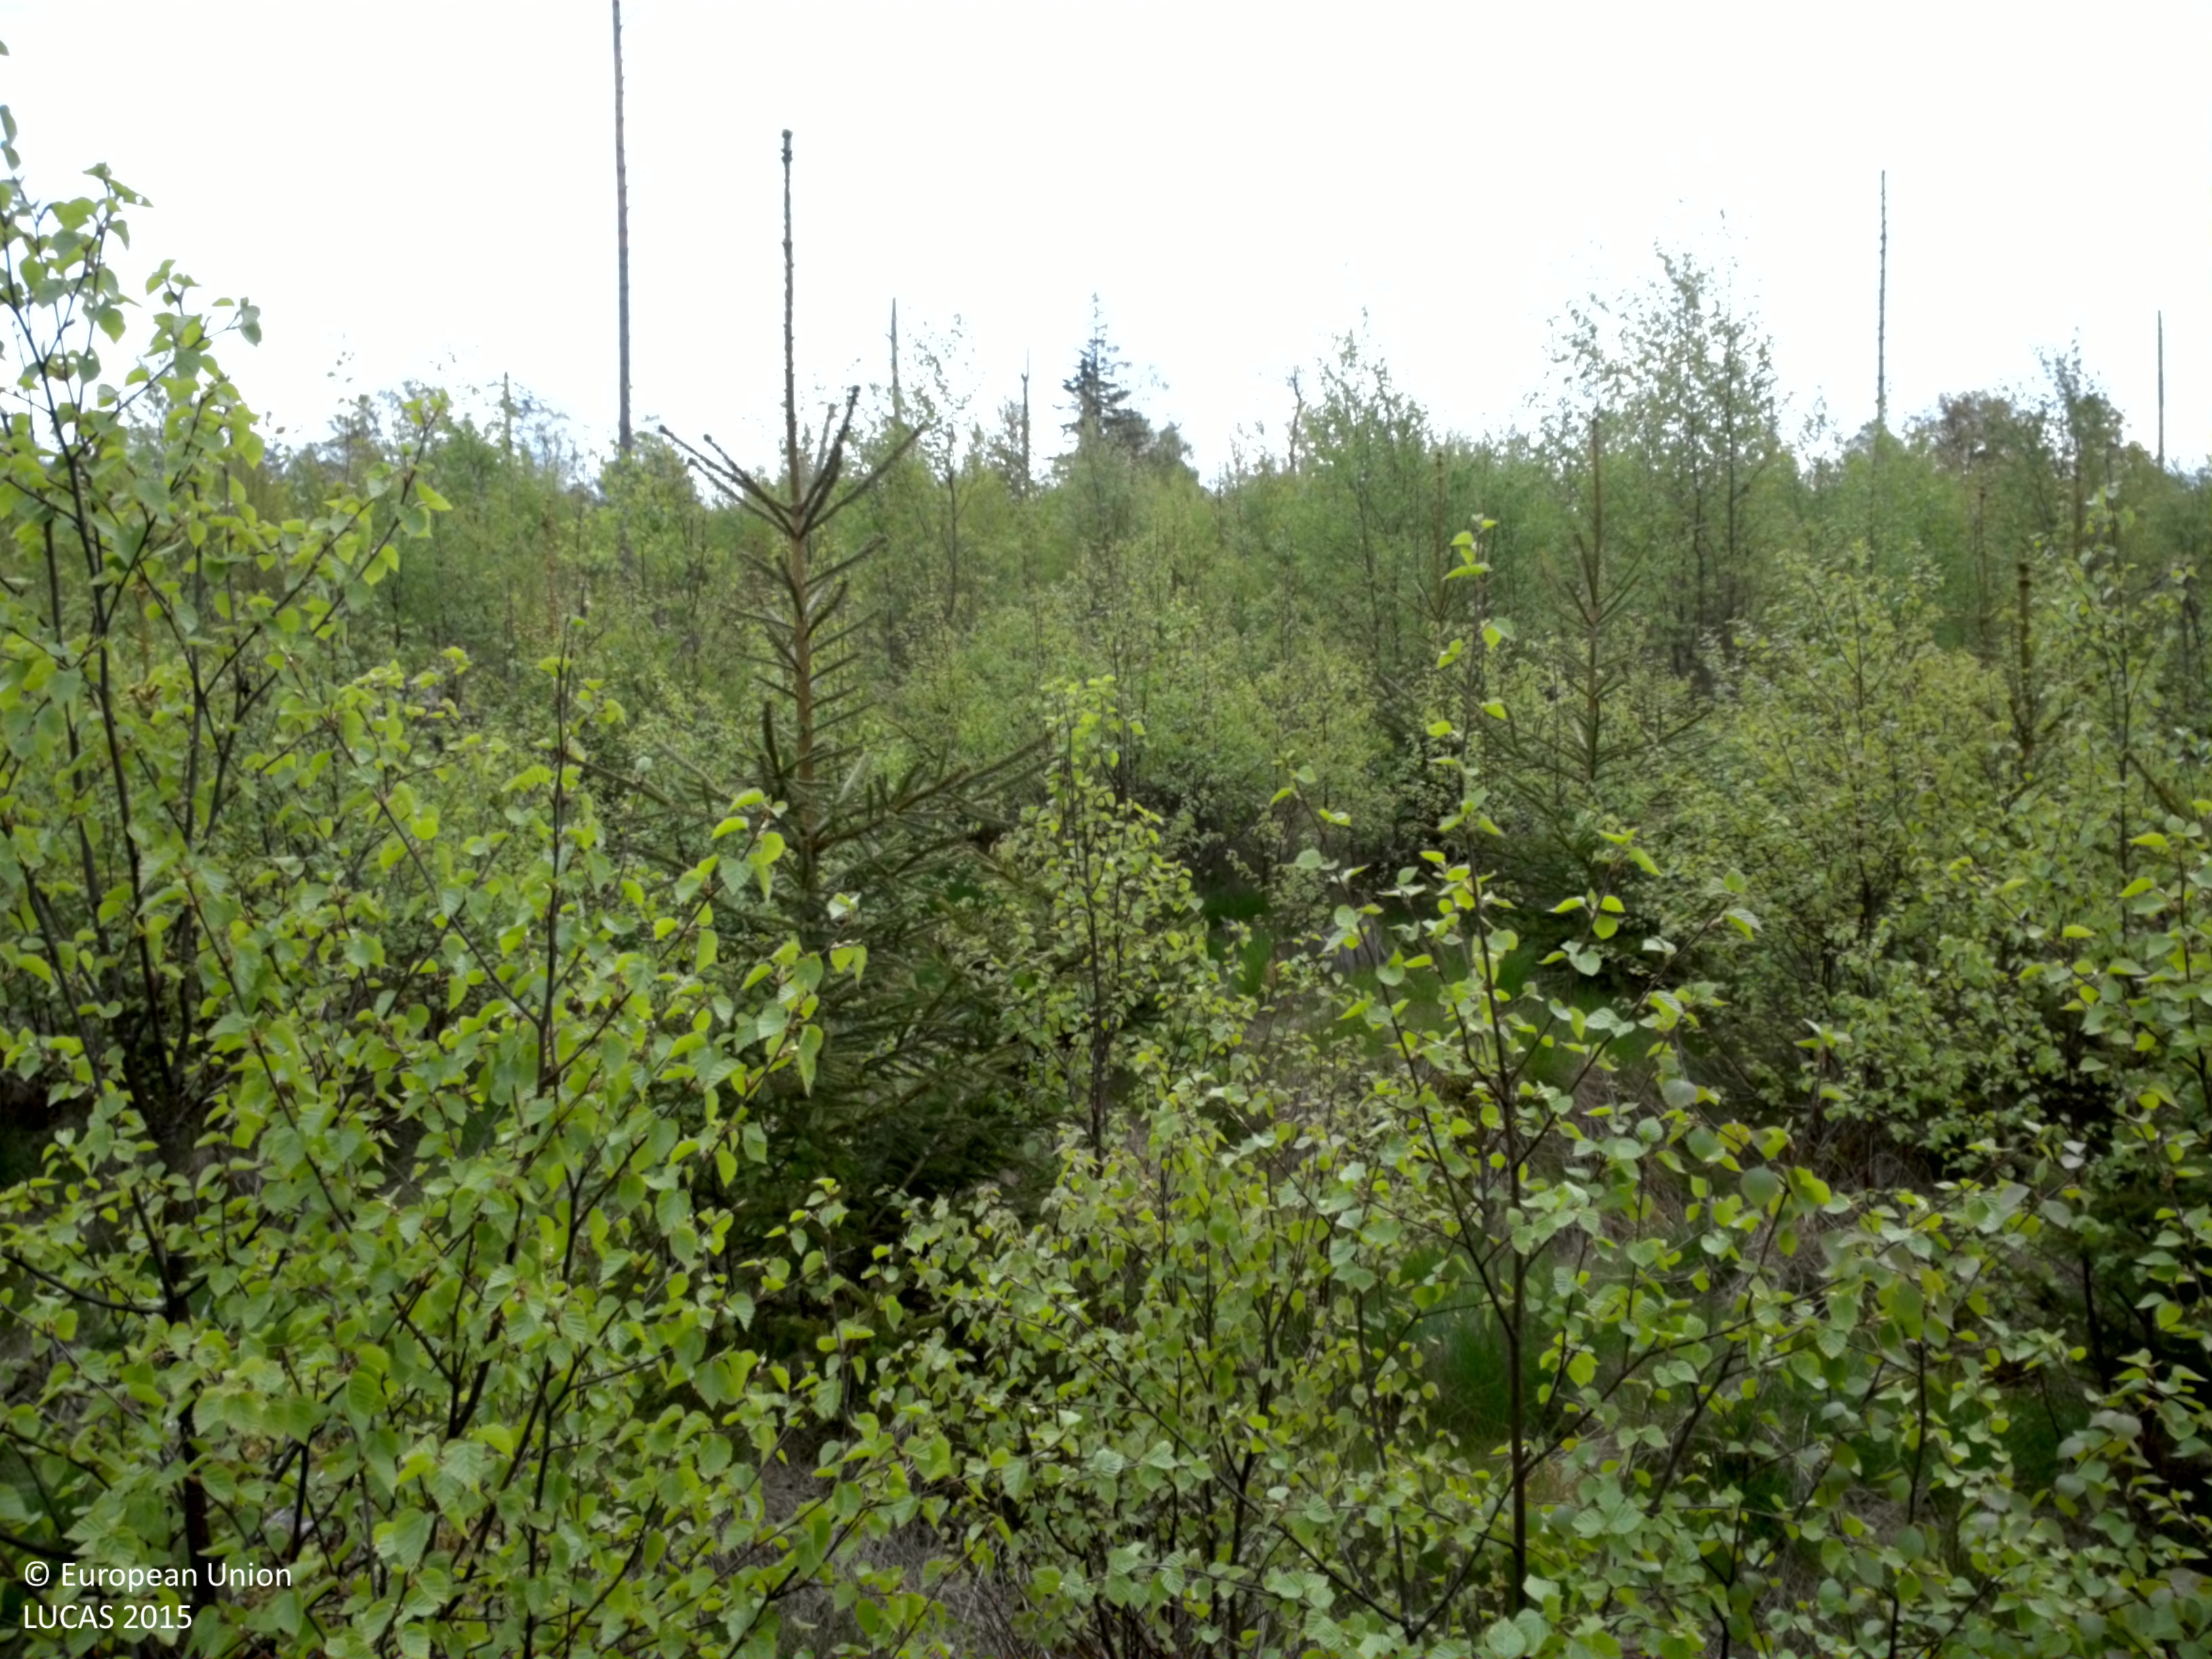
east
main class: Woodland
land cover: Spruce dominated mixed woodland
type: boreal forest
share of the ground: 50 - 75 %
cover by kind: broadleaved forest trees 40 %, coniferous forest trees 35 %, shrubs 10 %, herbaceous plants 10 %, lichens and mosses 5 %
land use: Forestry
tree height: < 5 m
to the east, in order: Spruce dominated mixed woodland; Tracks; Spruce dominated mixed woodland; Broadleaved woodland; Paved roads, cycling and walking lanes; Grass margins; Fences; Broadleaved woodland; Grassland with sparse tree/shrub cover; Grassland without tree/shrub cover; Grassland with sparse tree/shrub cover; Fences; Grassland with sparse tree/shrub cover; Grassland without tree/shrub cover
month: May
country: SE
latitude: 56.9099
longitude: 15.2366
